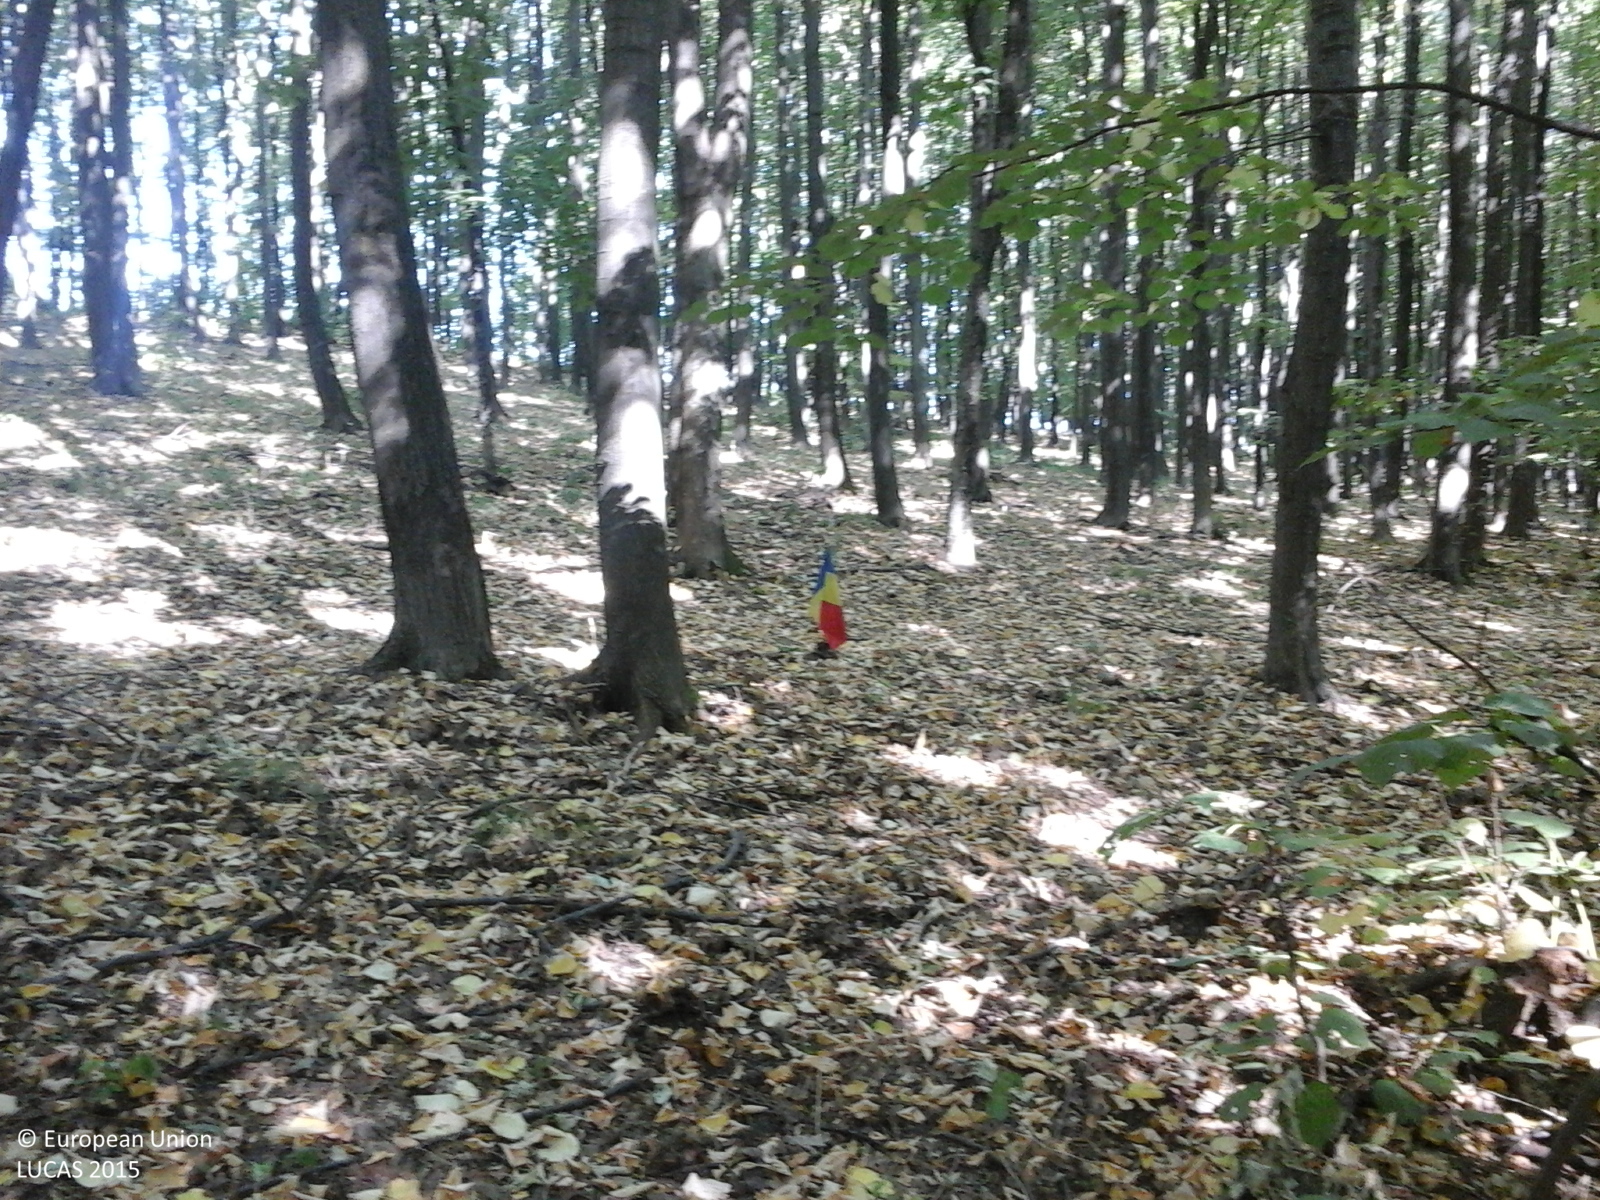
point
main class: Woodland
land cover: Broadleaved woodland
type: thermophilous deciduous forest
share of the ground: > 75 %
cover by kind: broadleaved forest trees 100 %
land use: Forestry
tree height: > 5 m
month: July
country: RO
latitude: 46.4505
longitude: 27.3286
